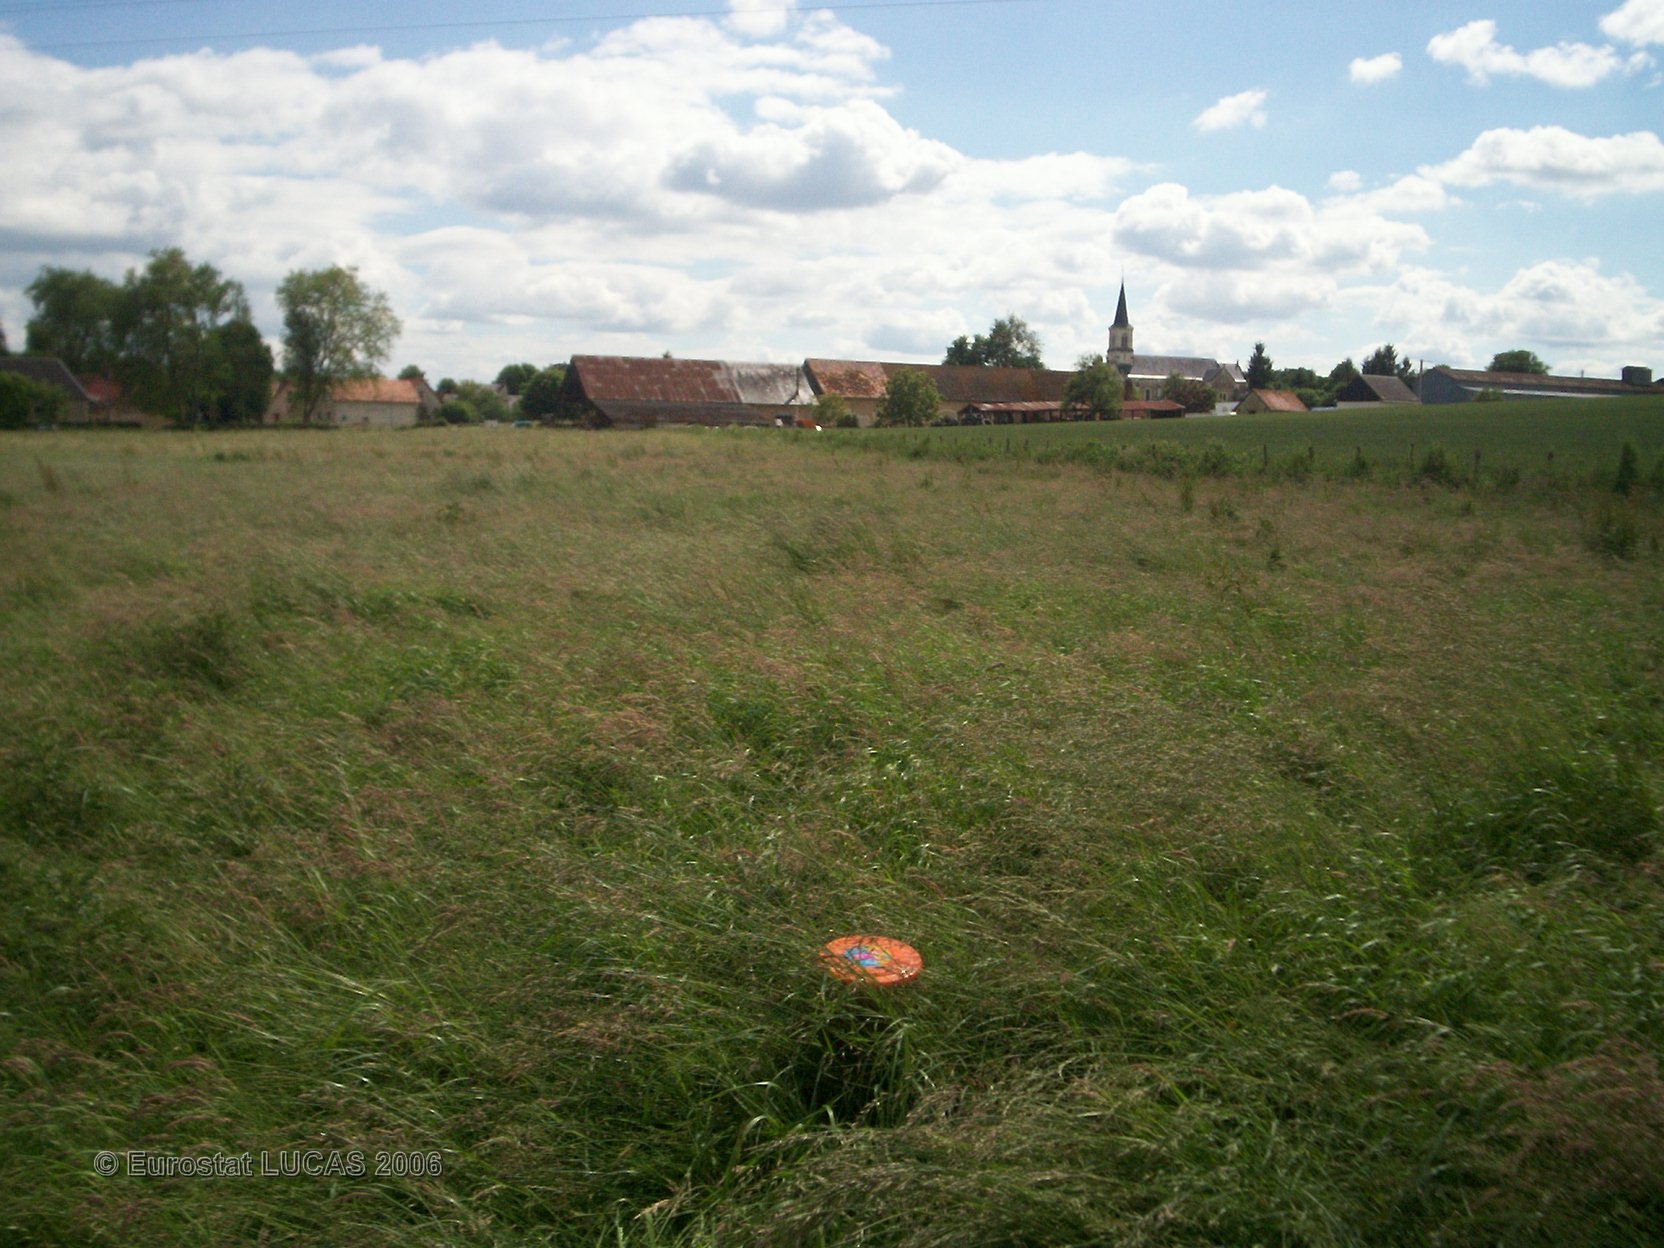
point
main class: Grassland
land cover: Grassland without tree/shrub cover
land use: Agriculture (excluding fallow land and kitchen gardens)
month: May
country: FR
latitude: 47.0641
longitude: 1.5215
